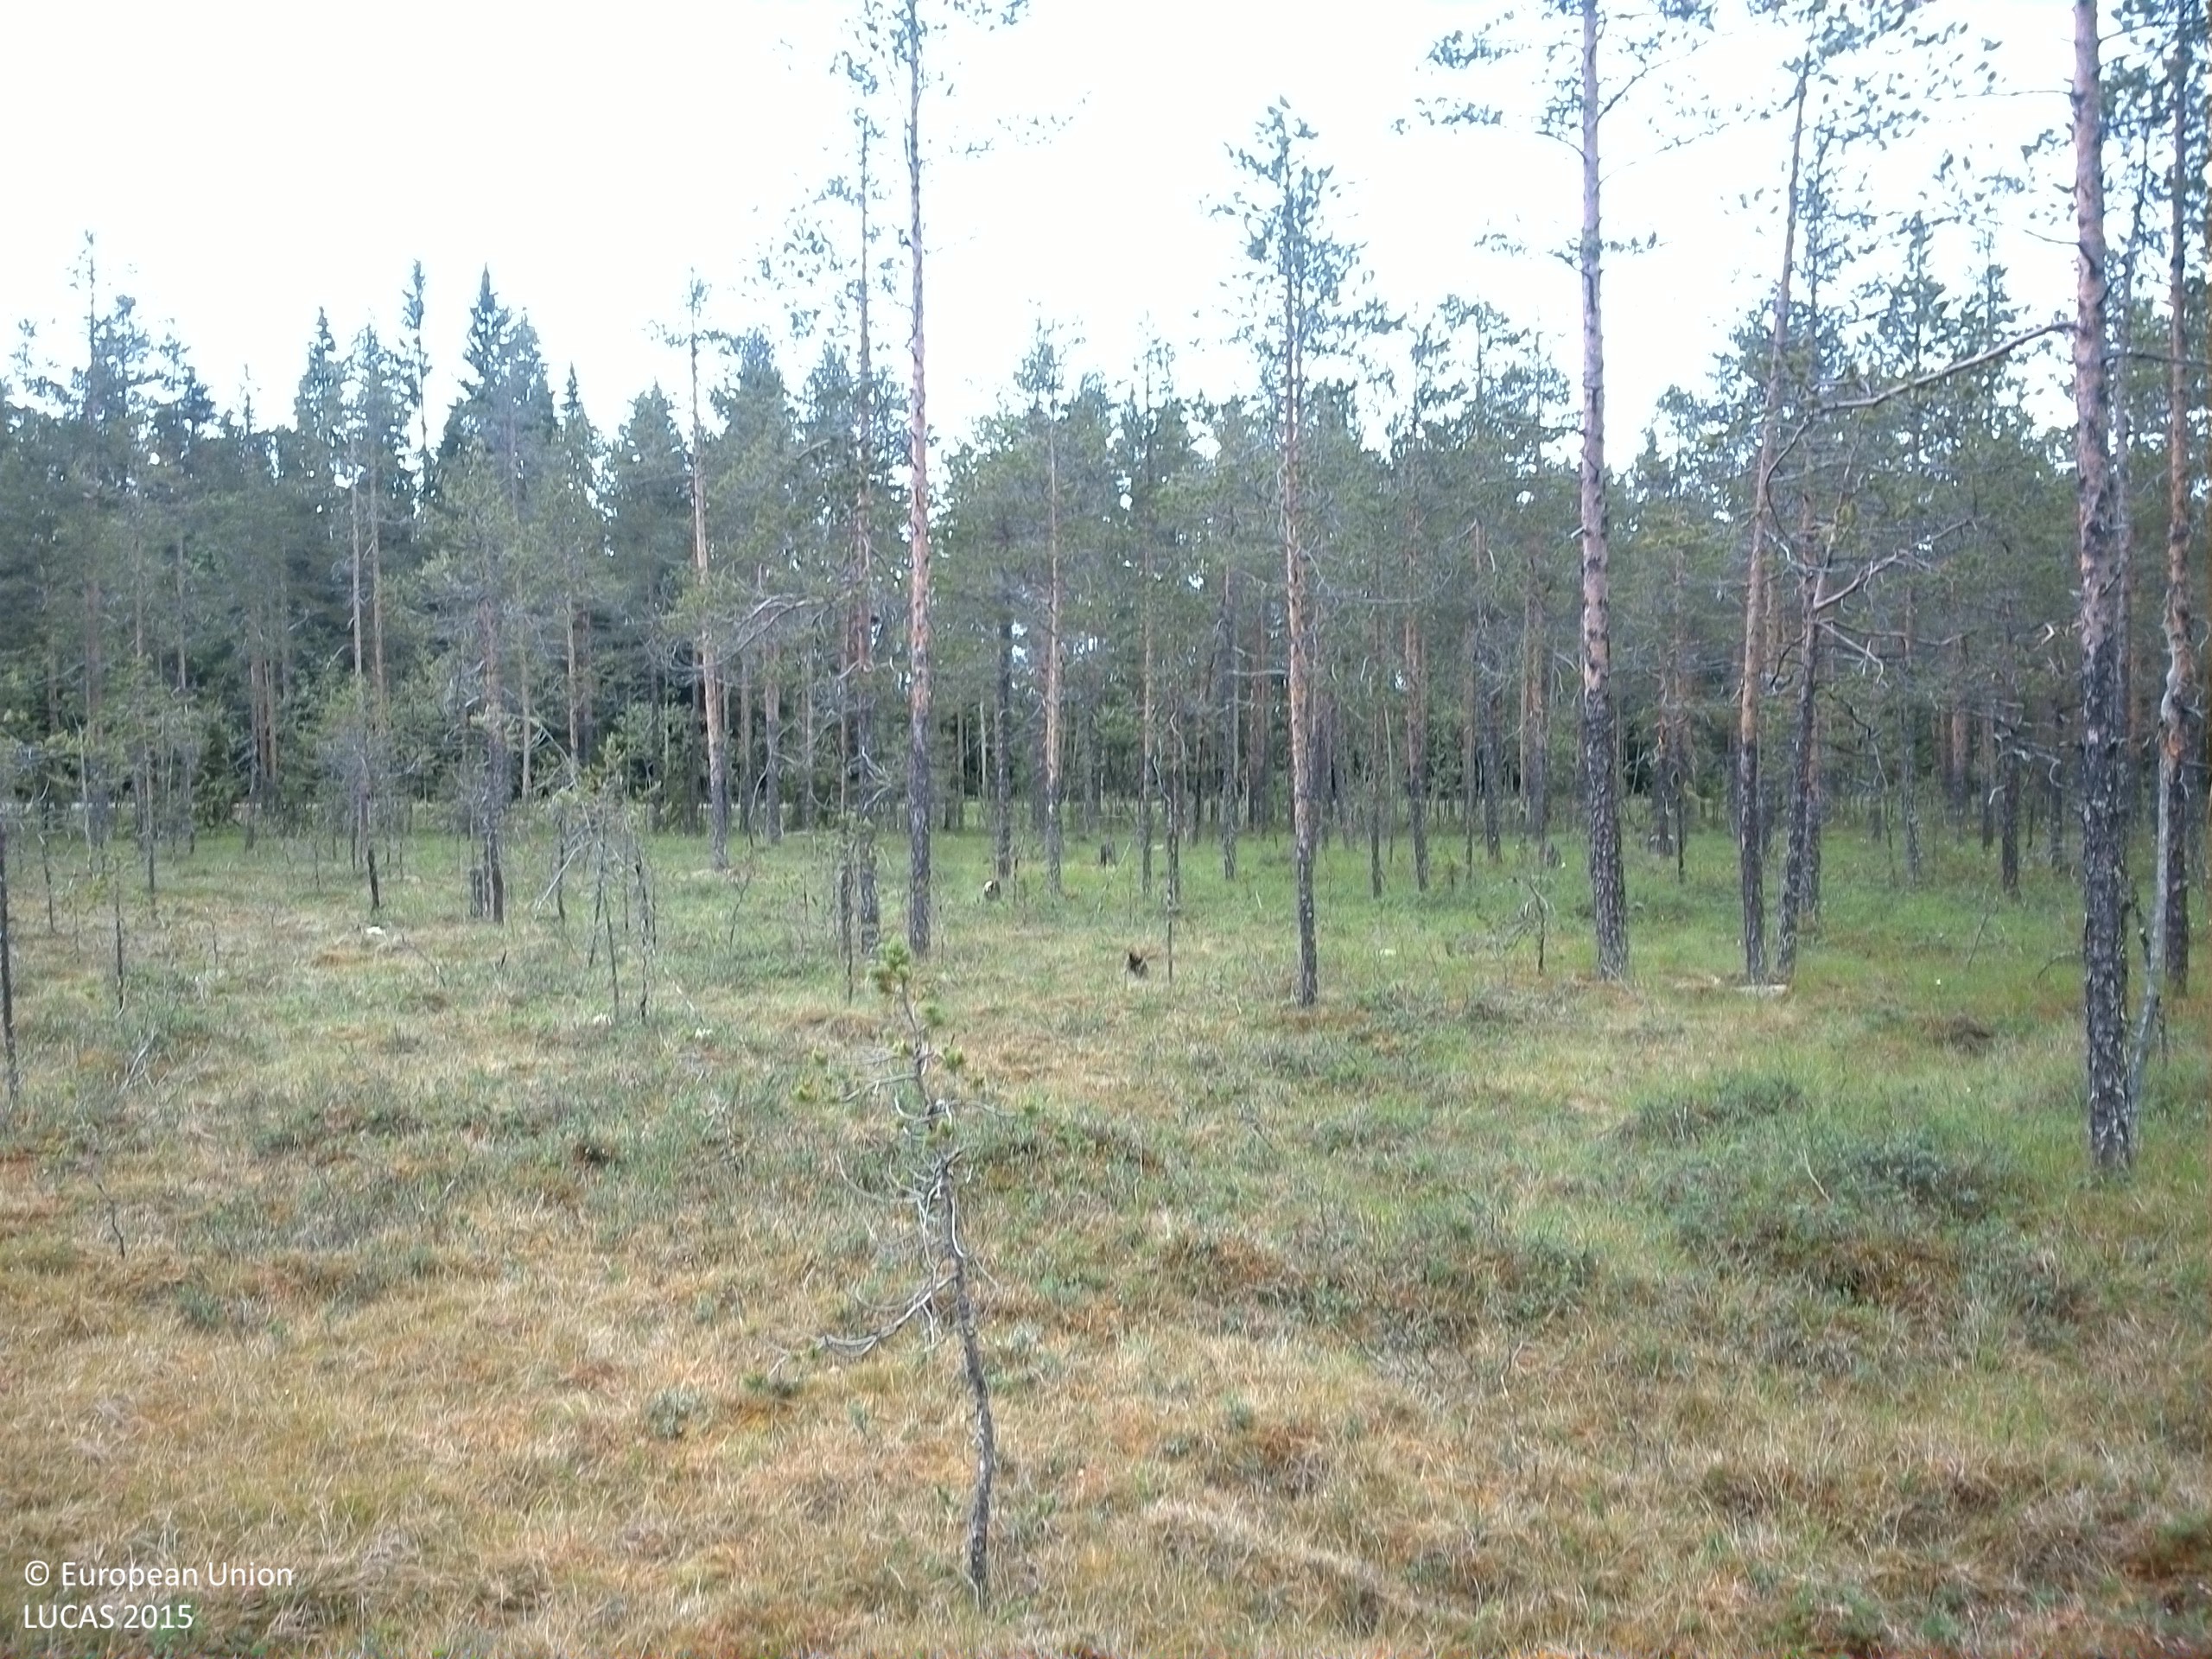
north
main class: Woodland
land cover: Pine dominated coniferous woodland
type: boreal forest
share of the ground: 10 - 25 %
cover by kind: lichens and mosses 80 %, coniferous forest trees 15 %, shrubs 5 %
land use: Semi-natural and natural areas not in use
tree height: > 5 m
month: July
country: SE
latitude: 63.6312
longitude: 18.7138
